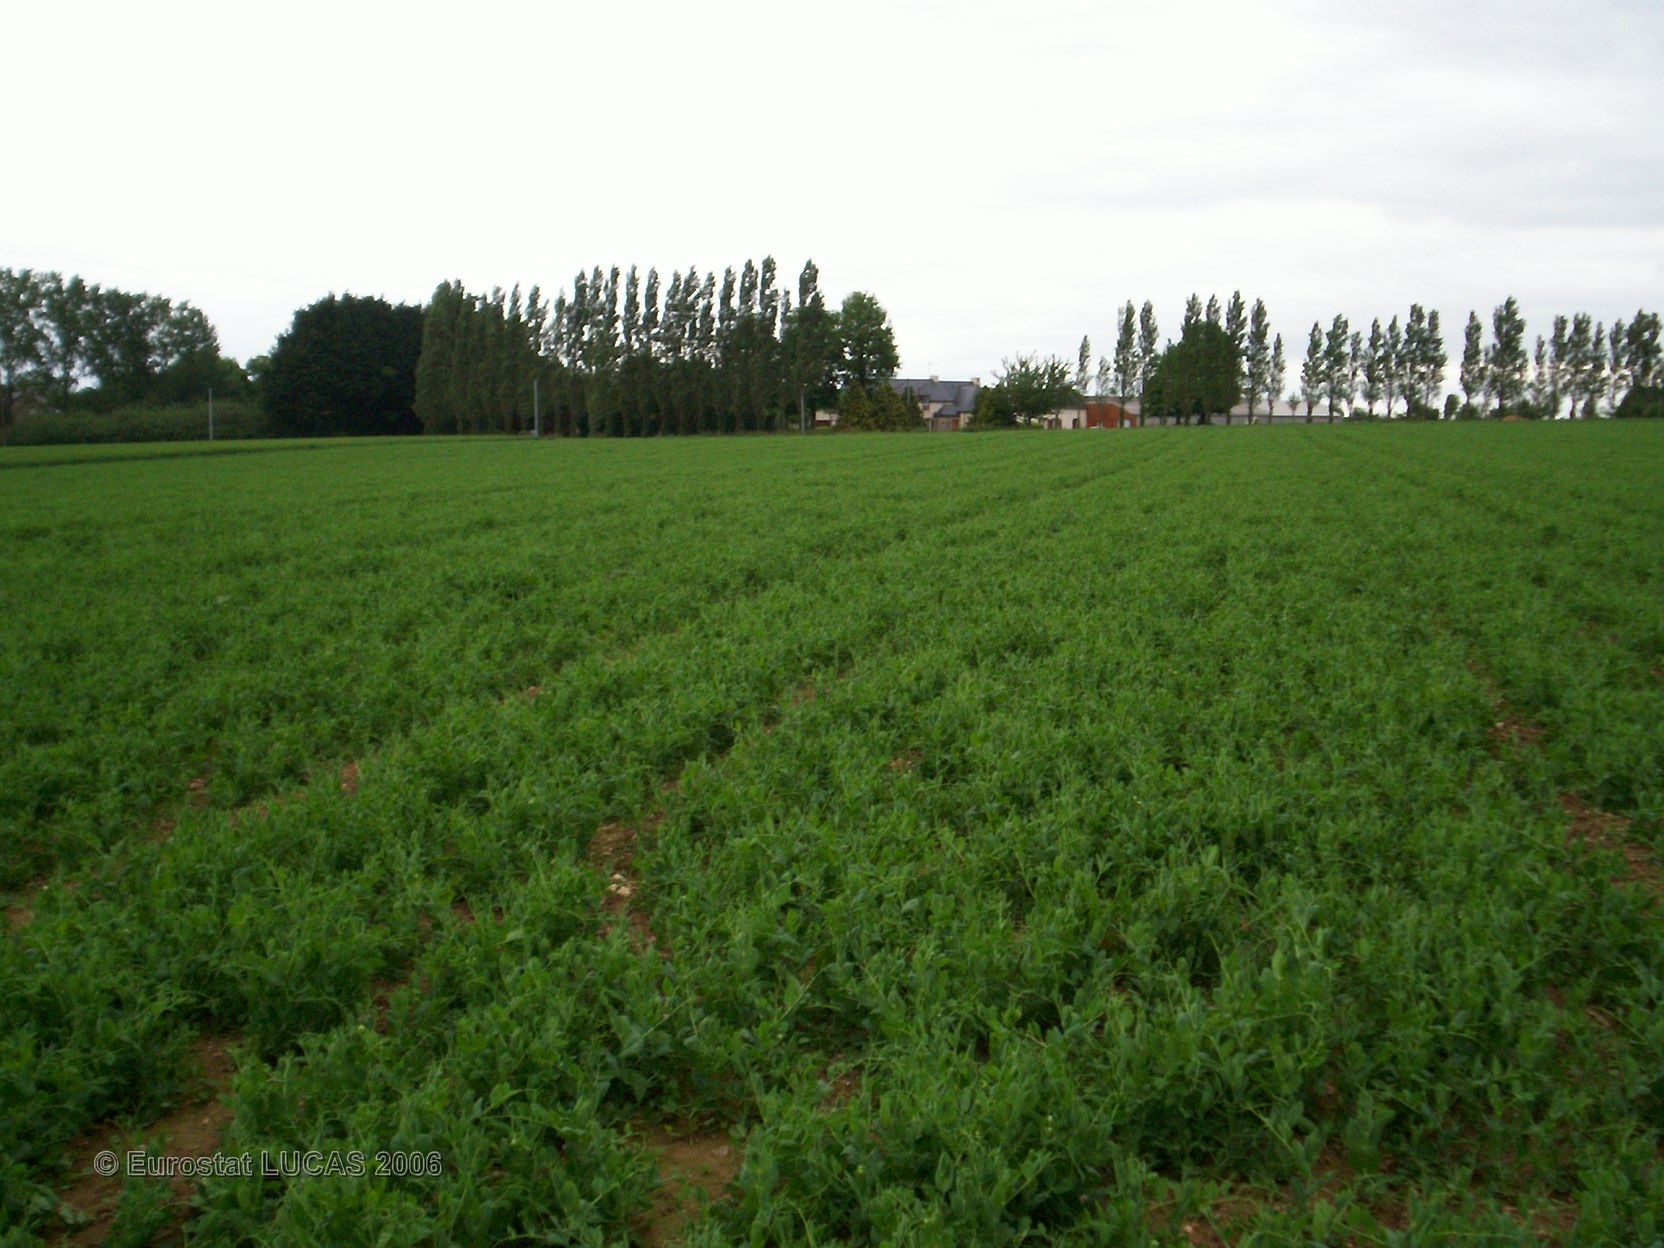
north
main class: Cropland
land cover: Dry pulses
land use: Agriculture (excluding fallow land and kitchen gardens)
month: May
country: FR
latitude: 48.1295
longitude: -2.3247
